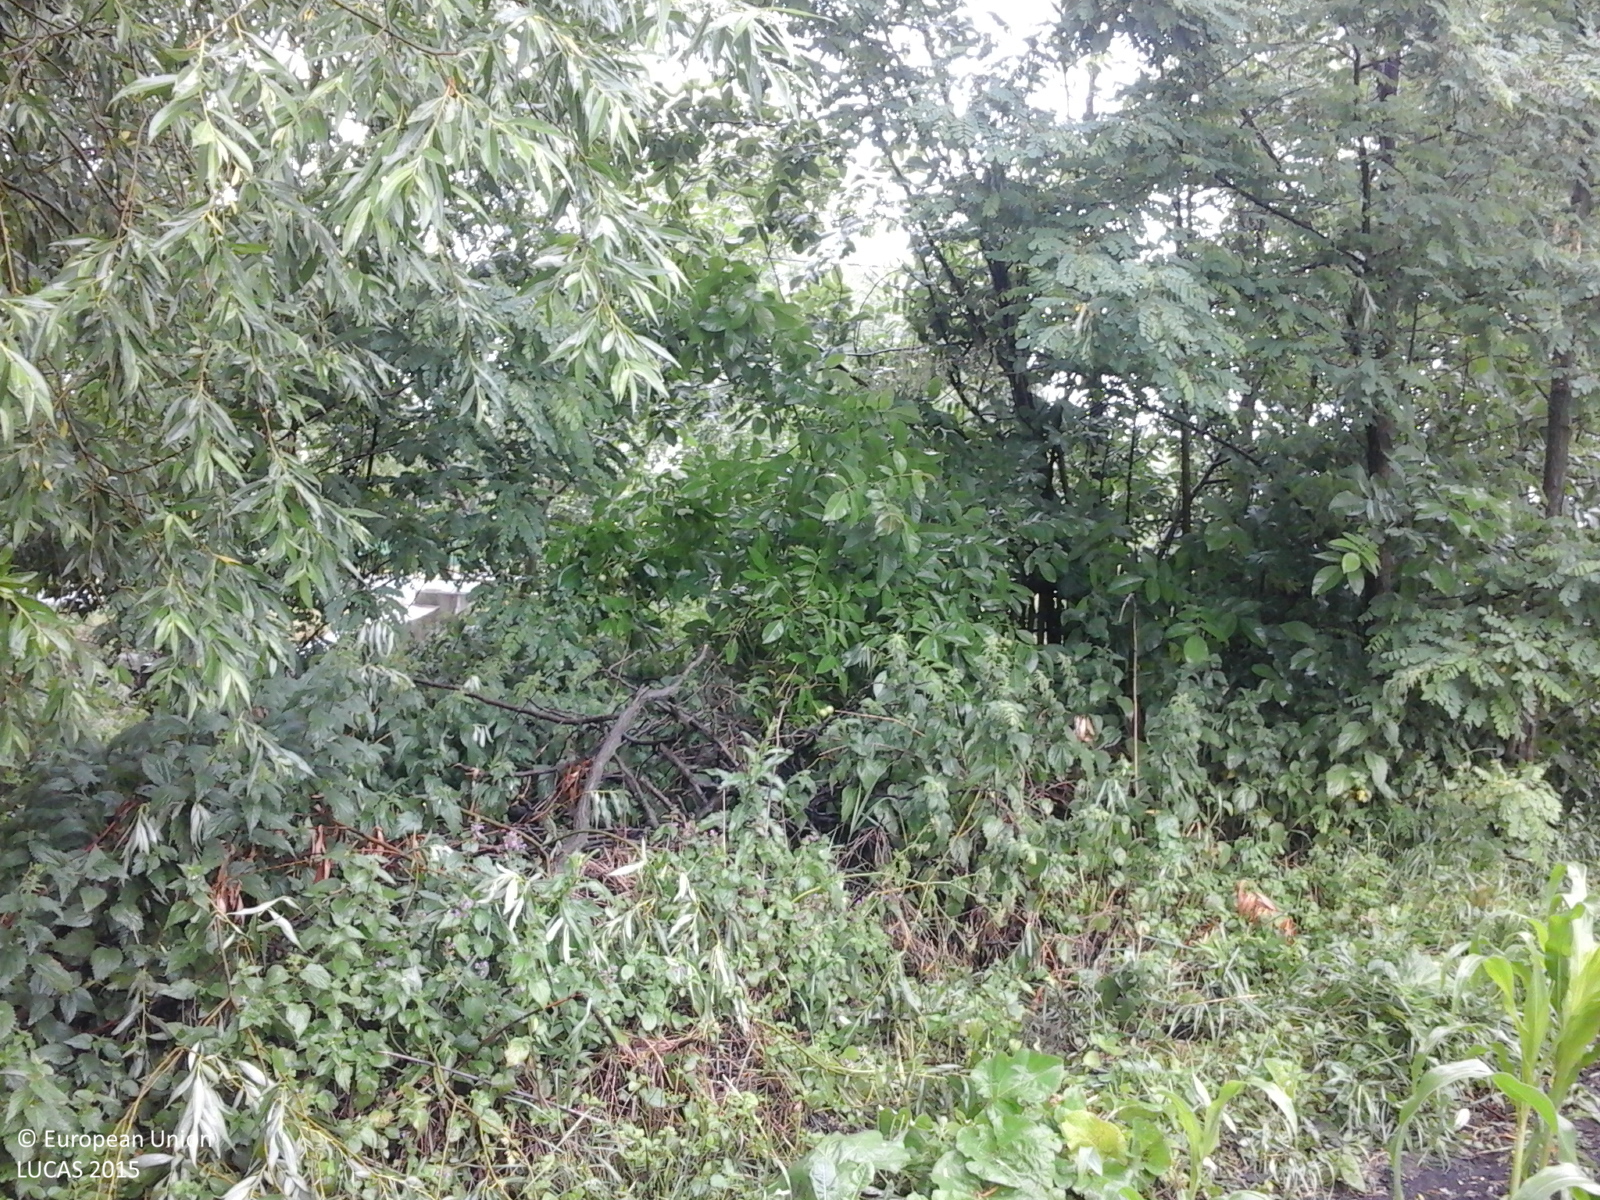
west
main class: Cropland
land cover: Maize
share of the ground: > 75 %
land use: Agriculture (excluding fallow land and kitchen gardens)
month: June
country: RO
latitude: 47.4010
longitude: 26.3149
